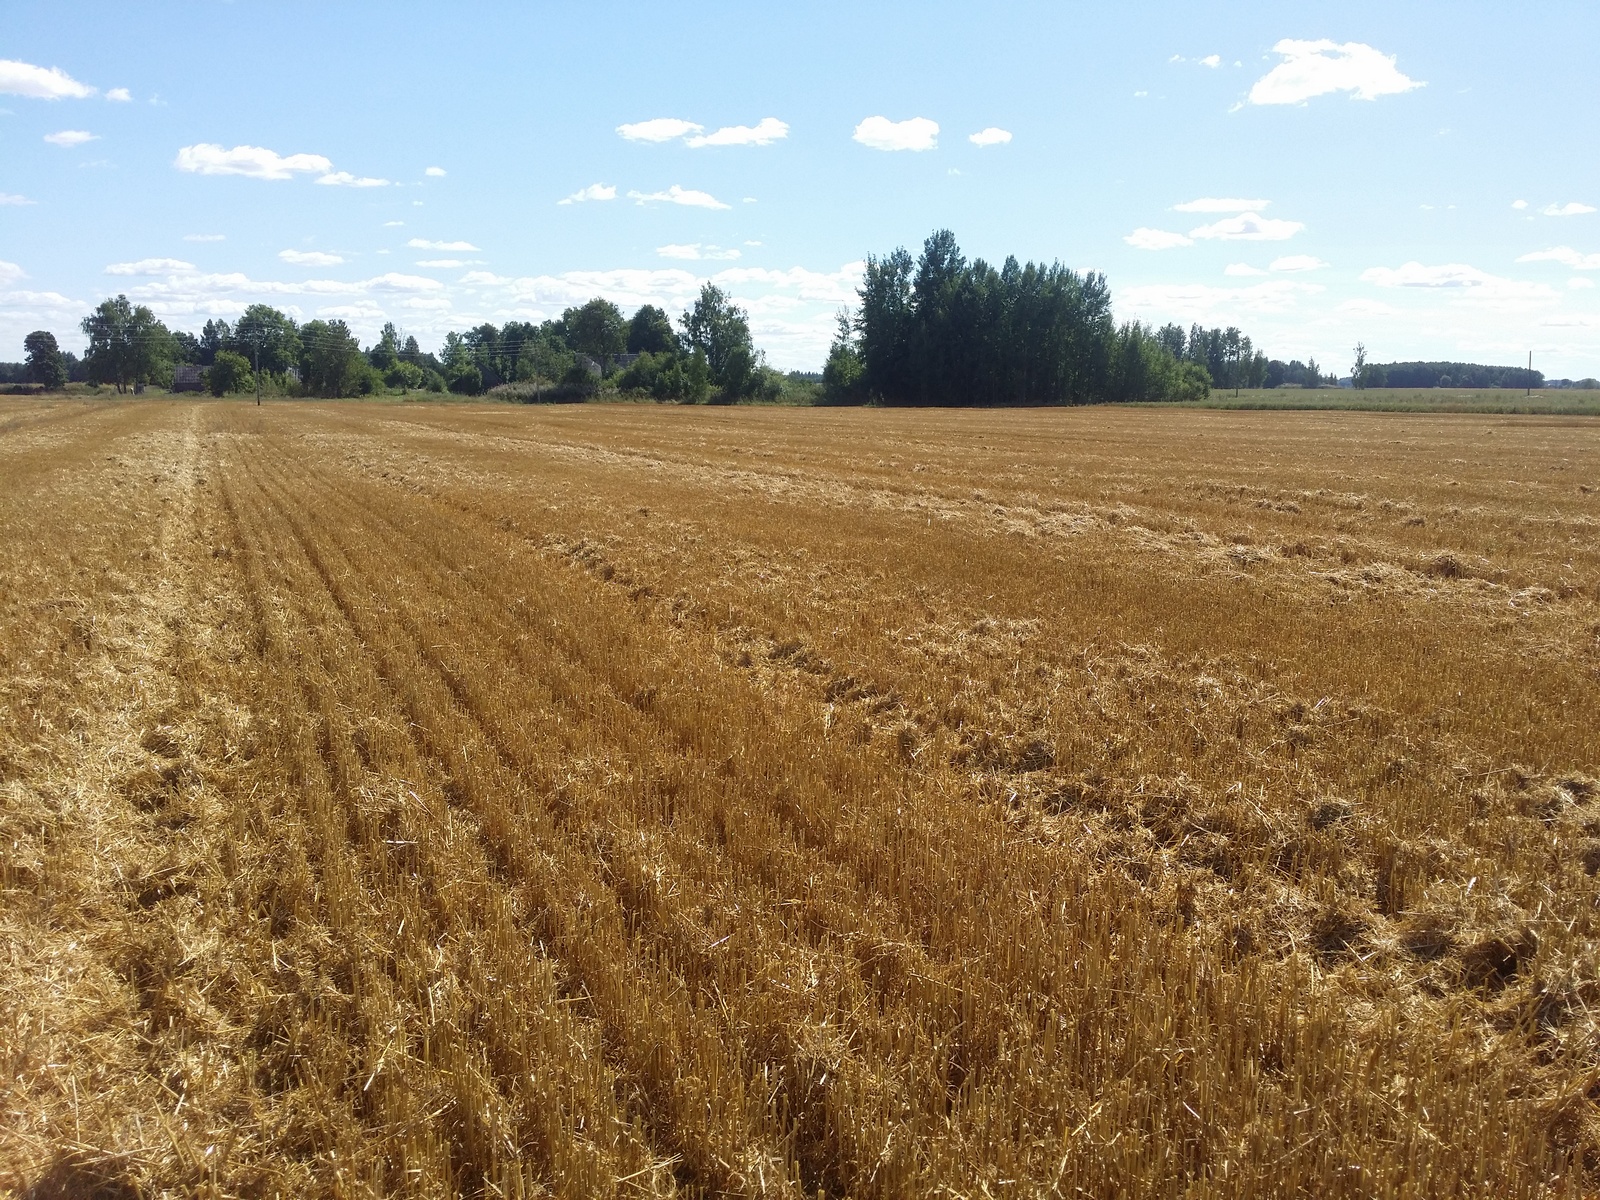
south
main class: Cropland
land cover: Common wheat
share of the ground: 50 - 75 %
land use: Agriculture (excluding fallow land and kitchen gardens)
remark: Harvested field
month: August
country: LV
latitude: 57.0168
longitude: 27.6567
